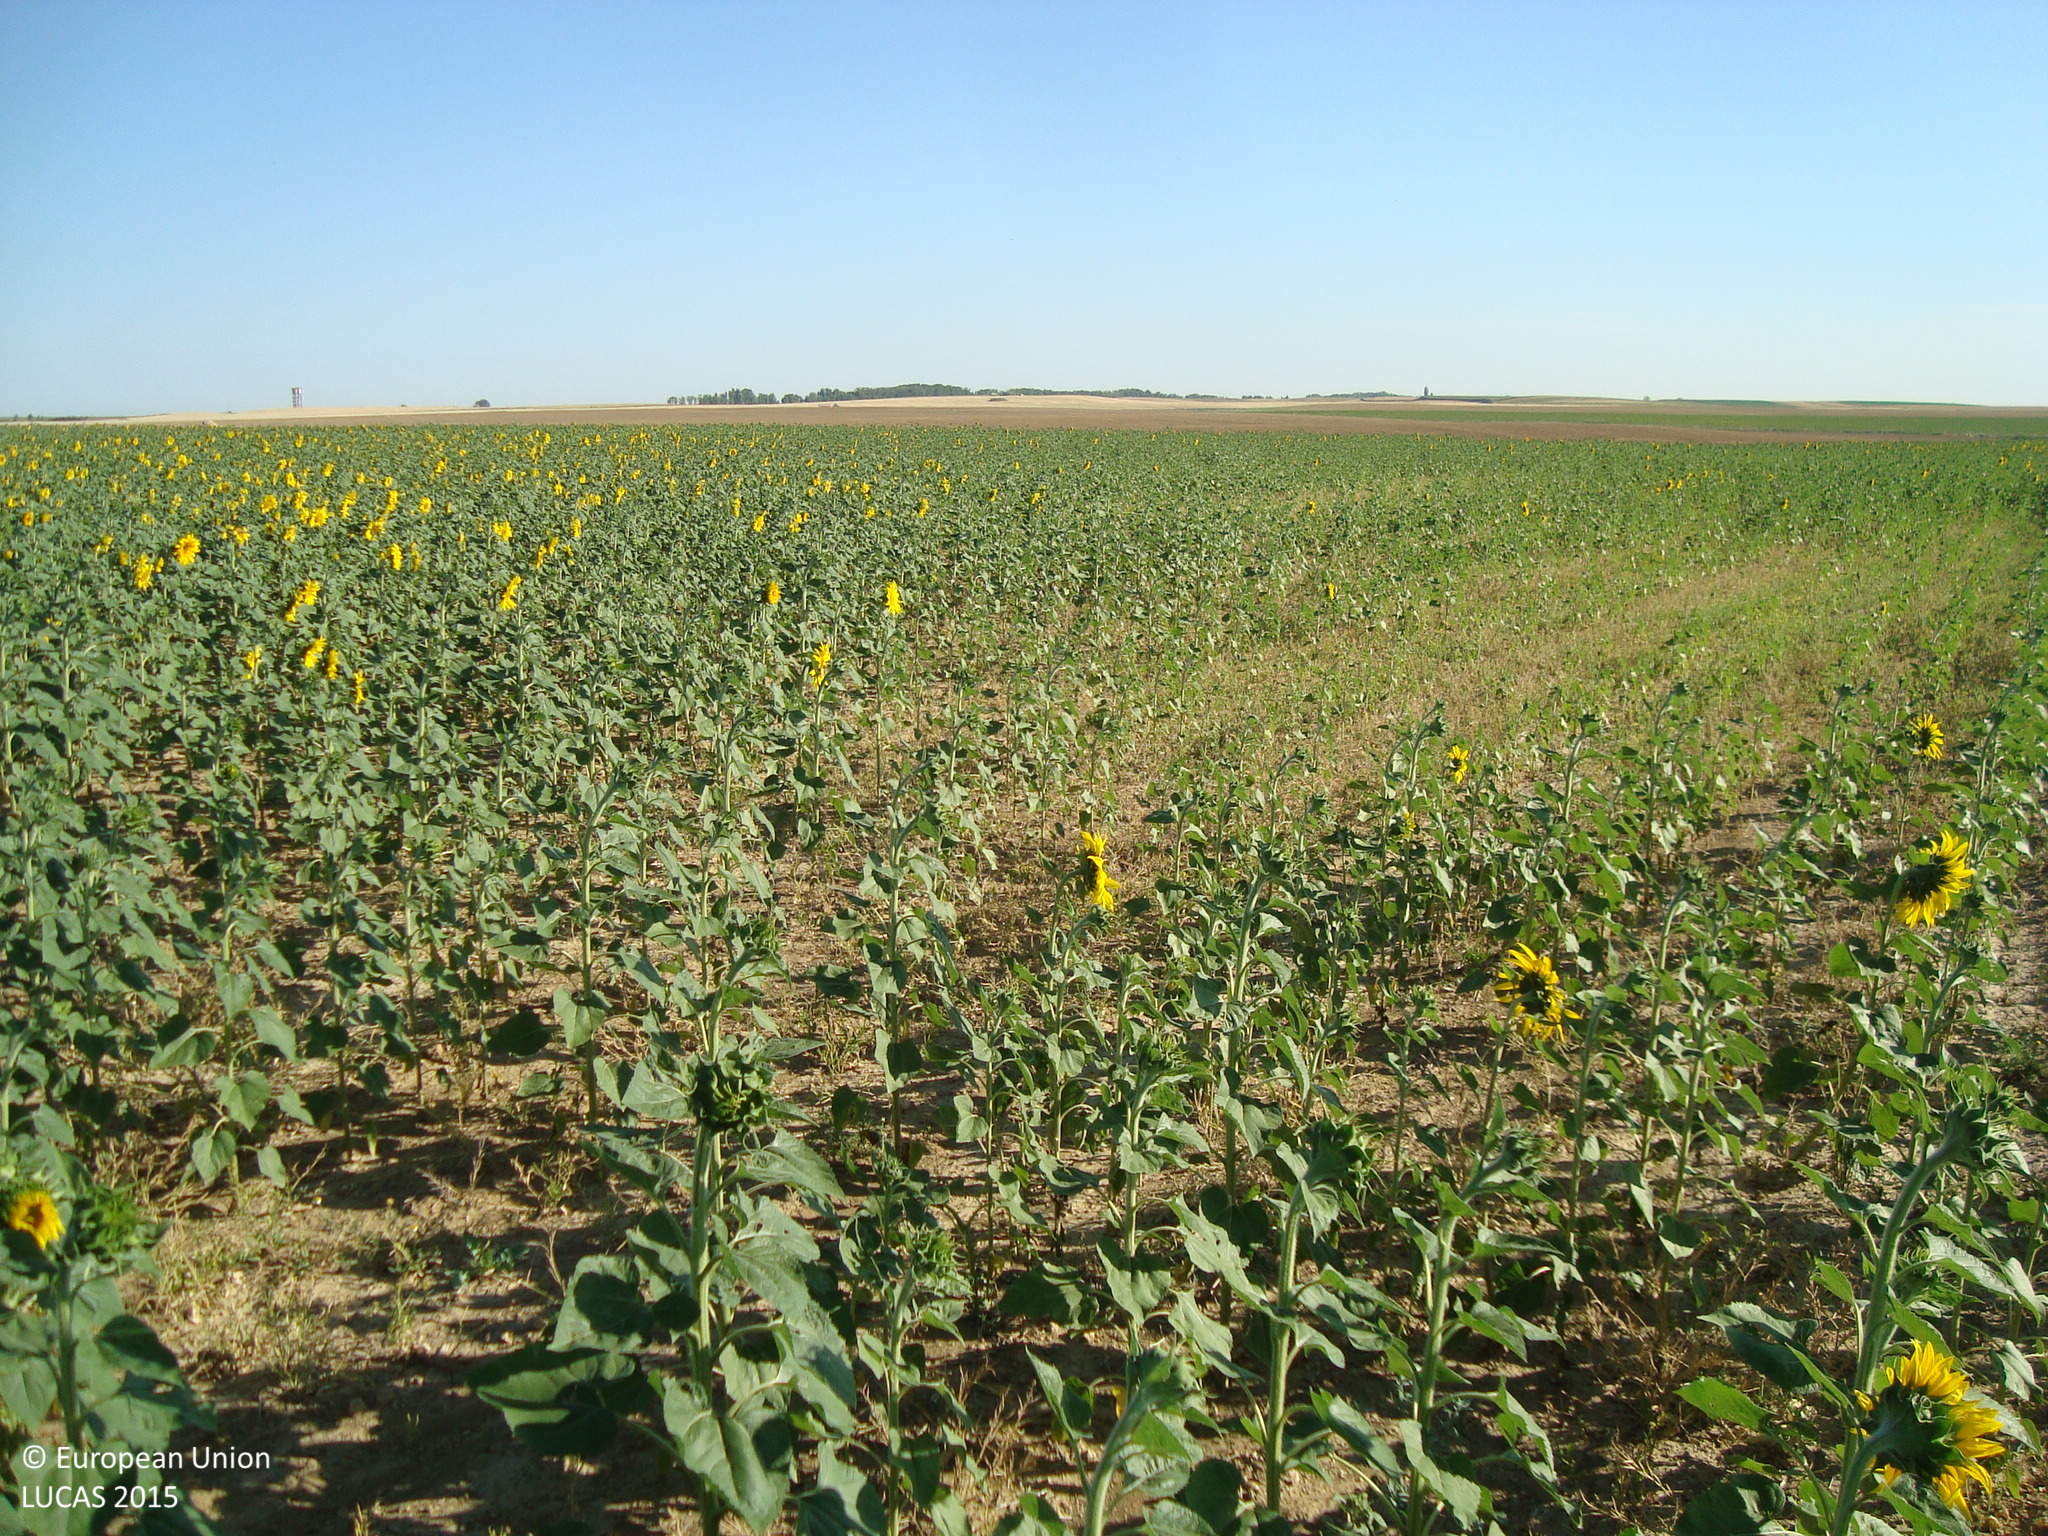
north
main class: Cropland
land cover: Sunflower
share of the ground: > 75 %
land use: Agriculture (excluding fallow land and kitchen gardens)
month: July
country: ES
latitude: 42.0081
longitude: -4.8671
